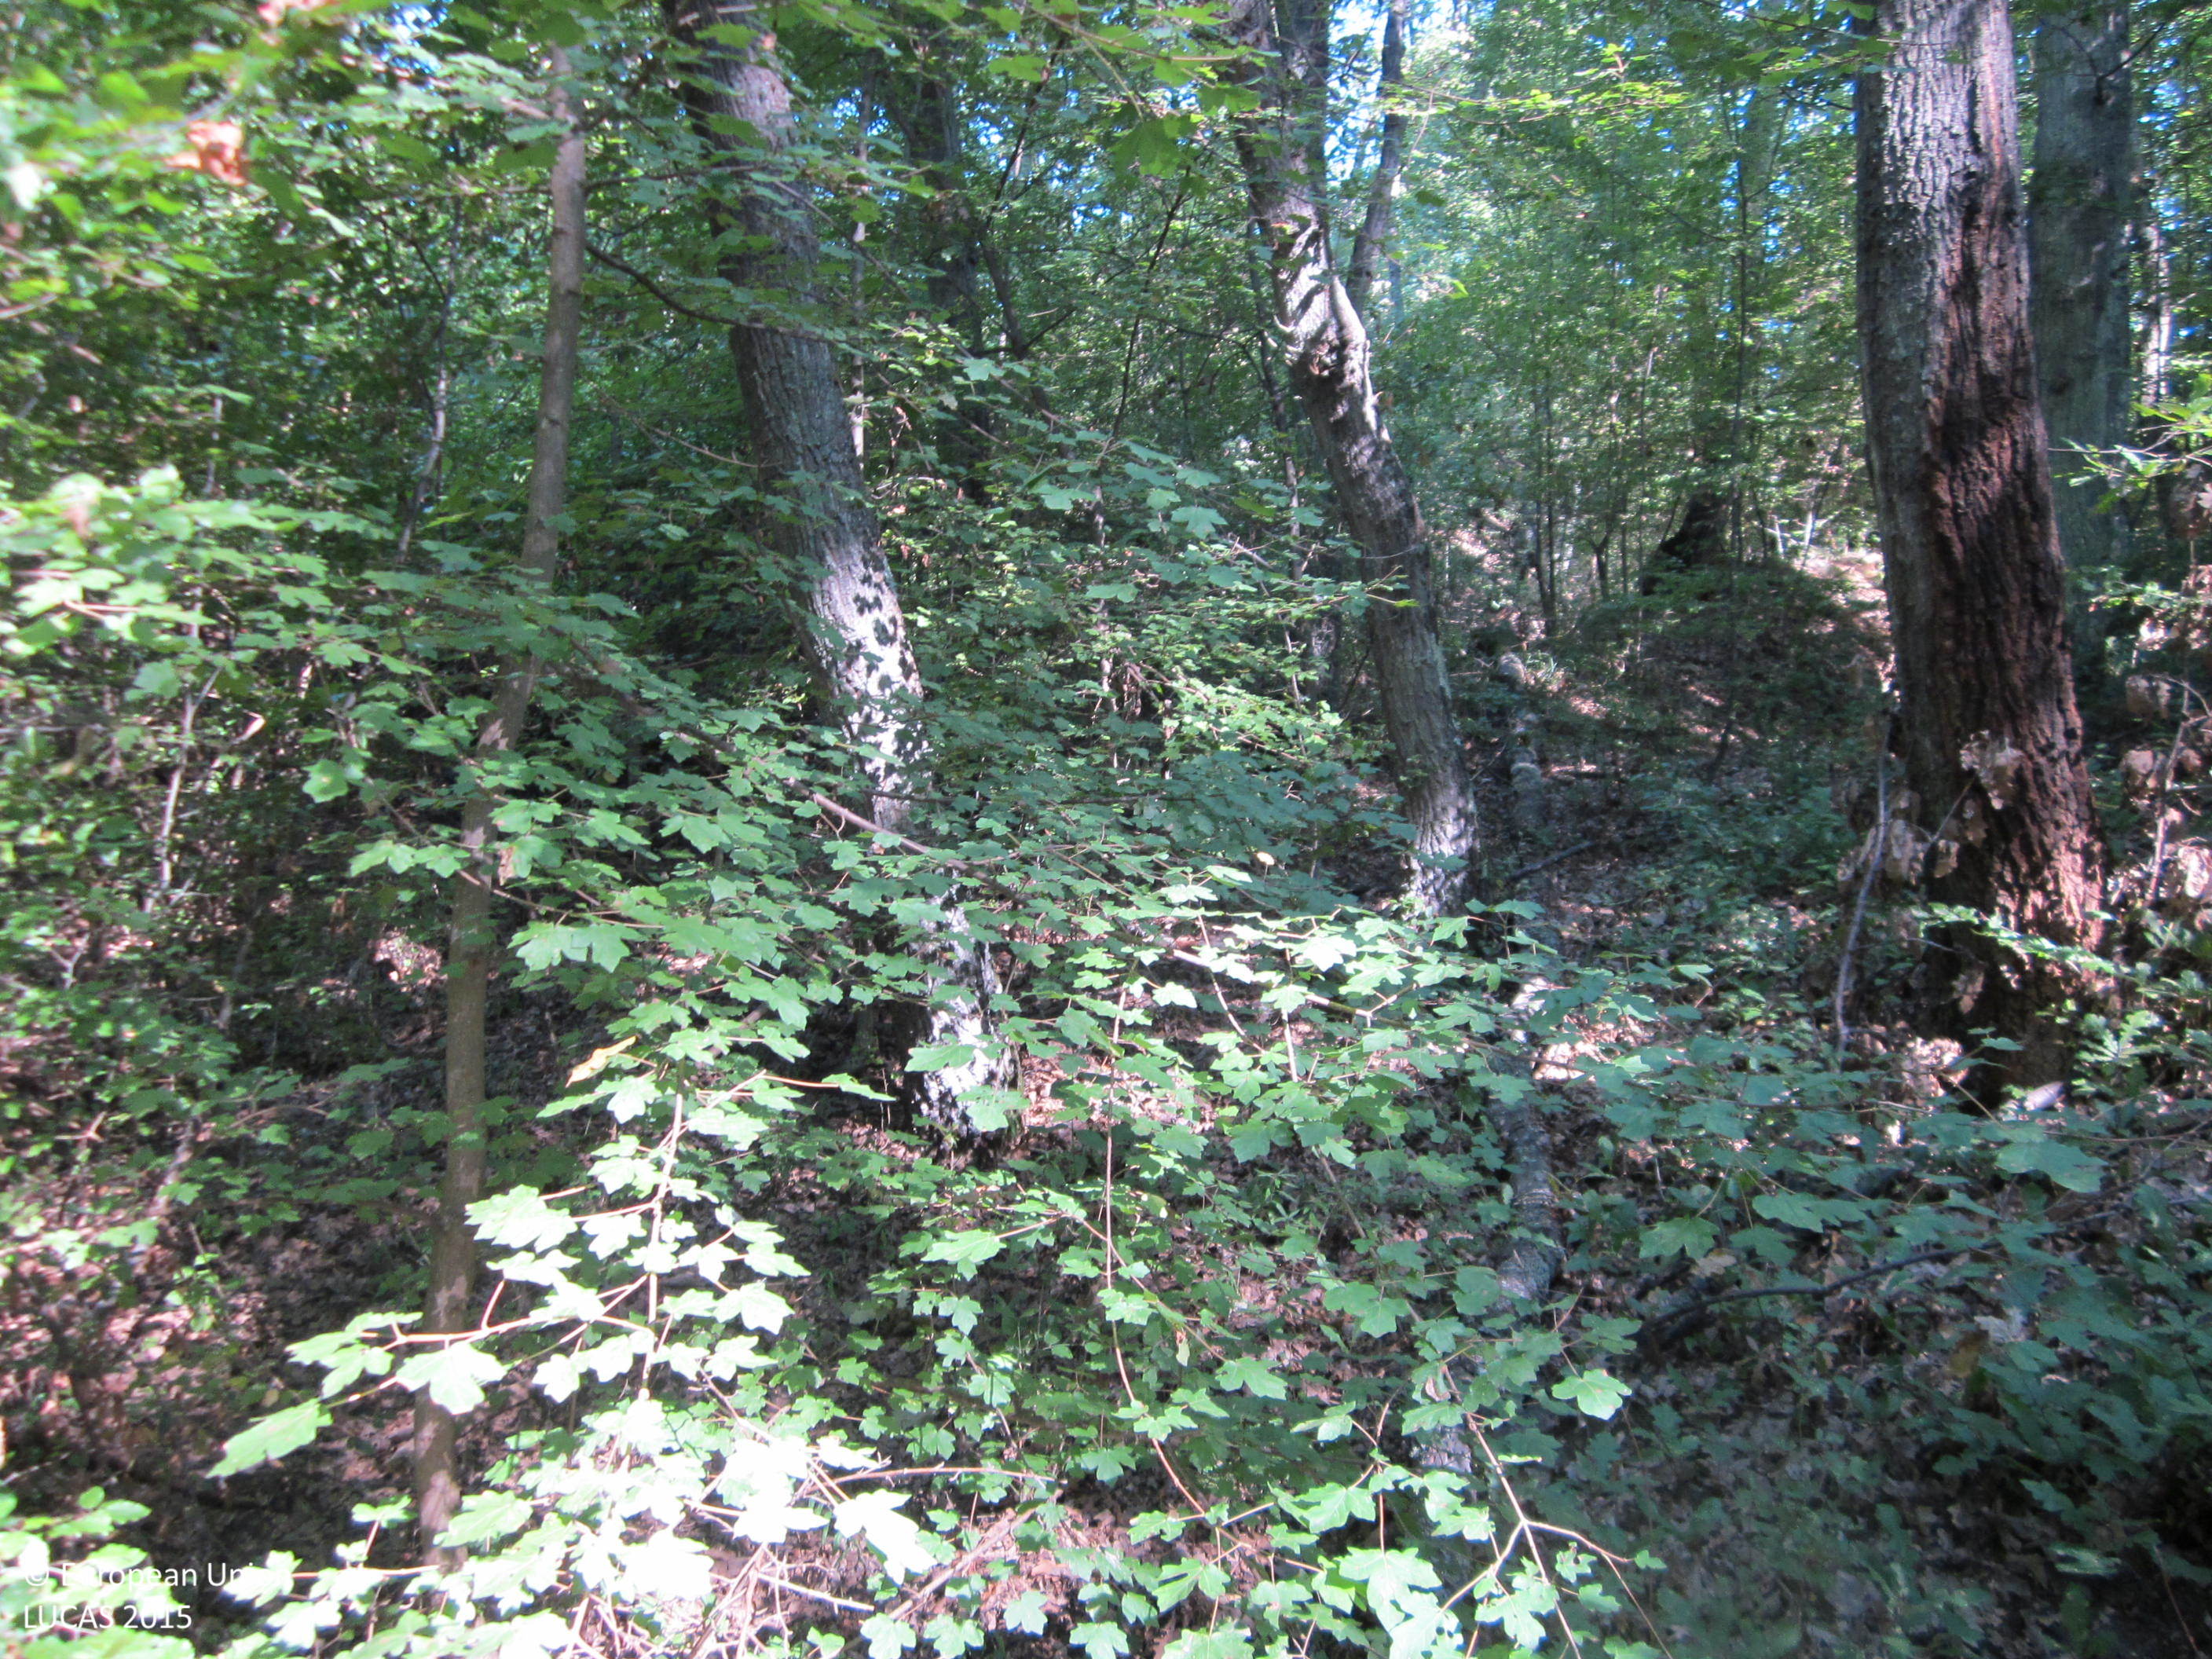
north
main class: Woodland
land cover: Broadleaved woodland
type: mesophytic deciduous forest
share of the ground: > 75 %
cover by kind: broadleaved forest trees 95 %, unconsolidated bare surface 5 %
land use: Forestry
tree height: > 5 m
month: September
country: BG
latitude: 42.8407
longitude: 26.9056
